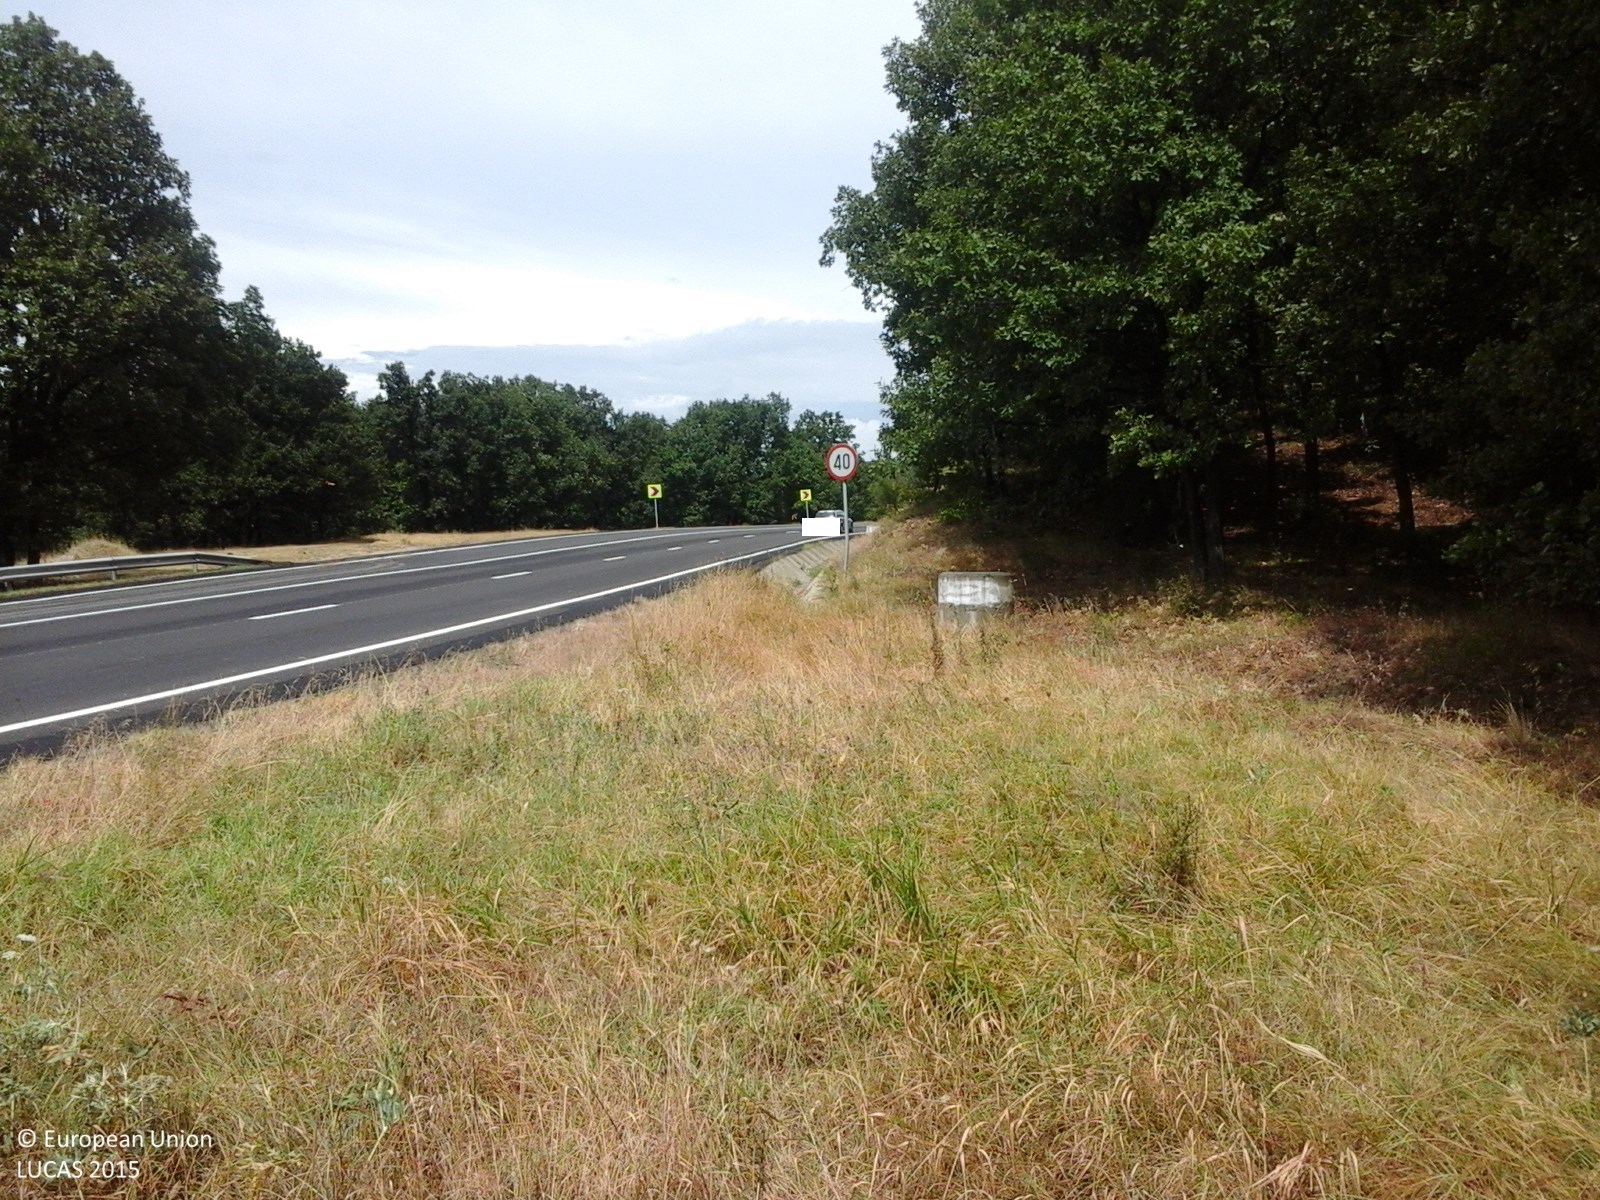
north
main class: Grassland
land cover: Grassland without tree/shrub cover
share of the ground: > 75 %
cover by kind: herbaceous plants 100 %
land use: Semi-natural and natural areas not in use
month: August
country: RO
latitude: 44.6142
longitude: 22.7834
